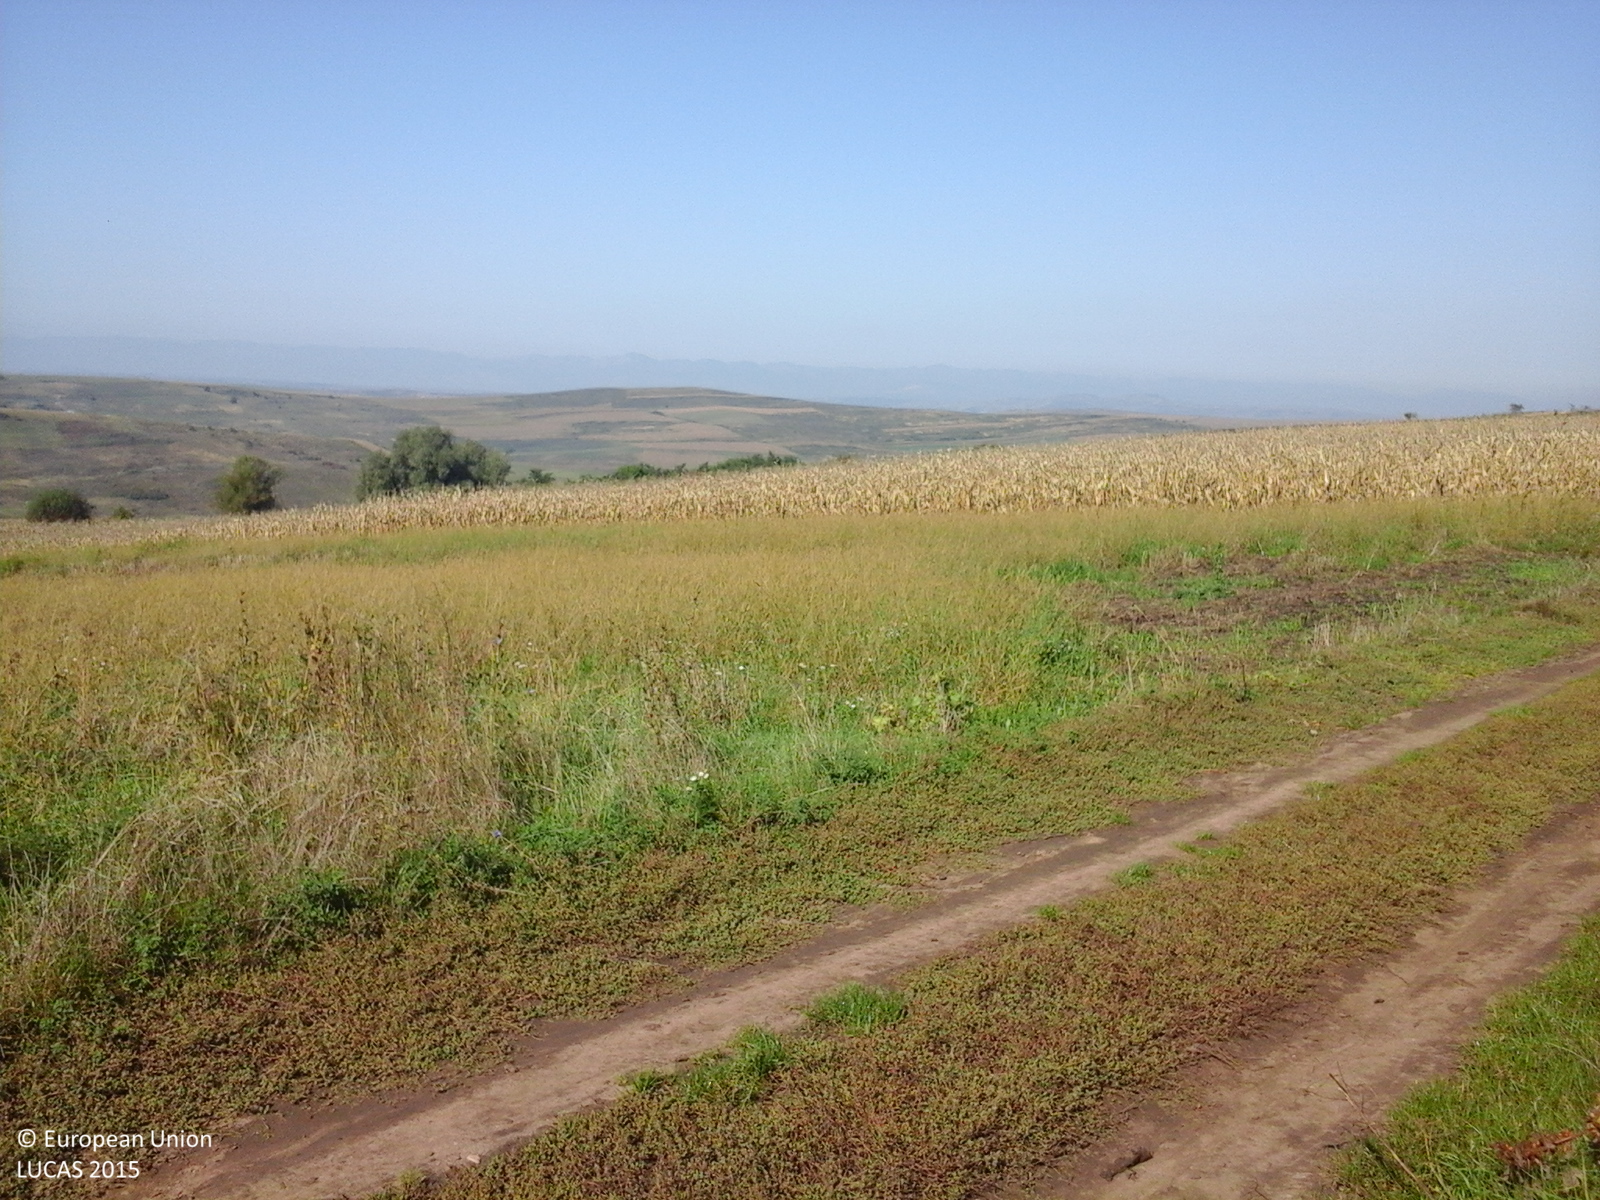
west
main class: Cropland
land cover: Maize
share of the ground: > 75 %
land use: Agriculture (excluding fallow land and kitchen gardens)
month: October
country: RO
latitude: 46.0993
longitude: 23.8741
